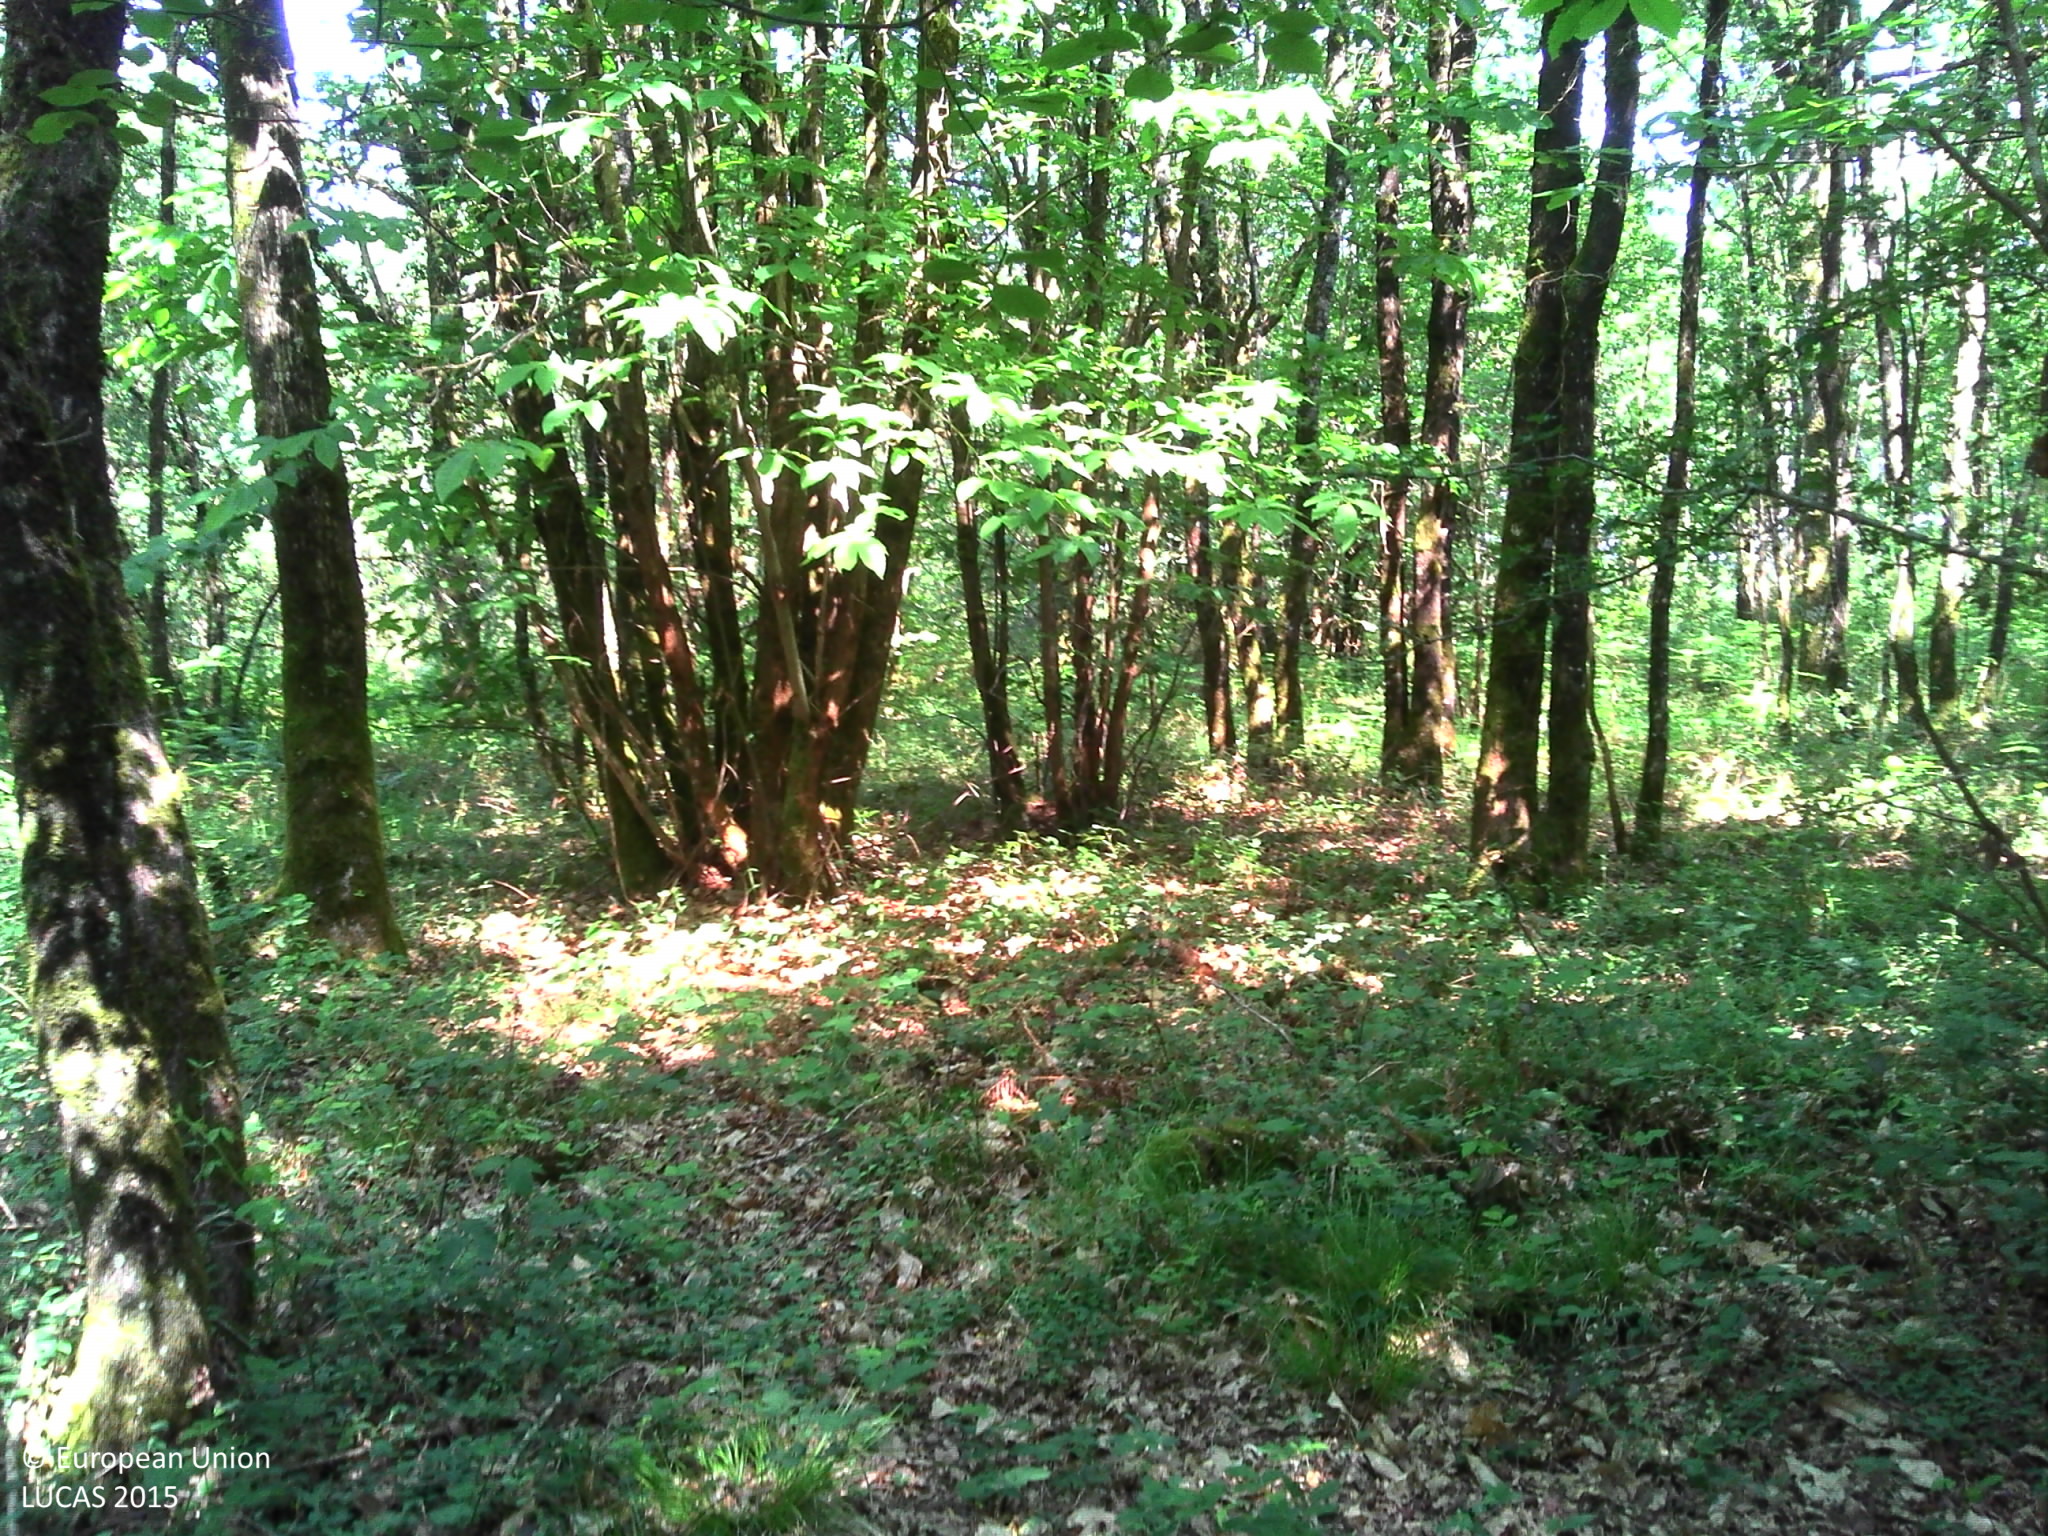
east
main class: Woodland
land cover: Broadleaved woodland
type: acidophilous oak and oak-birch forest
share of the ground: > 75 %
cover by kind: broadleaved forest trees 100 %
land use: Forestry
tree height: > 5 m
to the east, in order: Broadleaved woodland; Fences; Maize; Ditches and canals; Broadleaved woodland
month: June
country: FR
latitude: 46.0823
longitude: 0.6098
